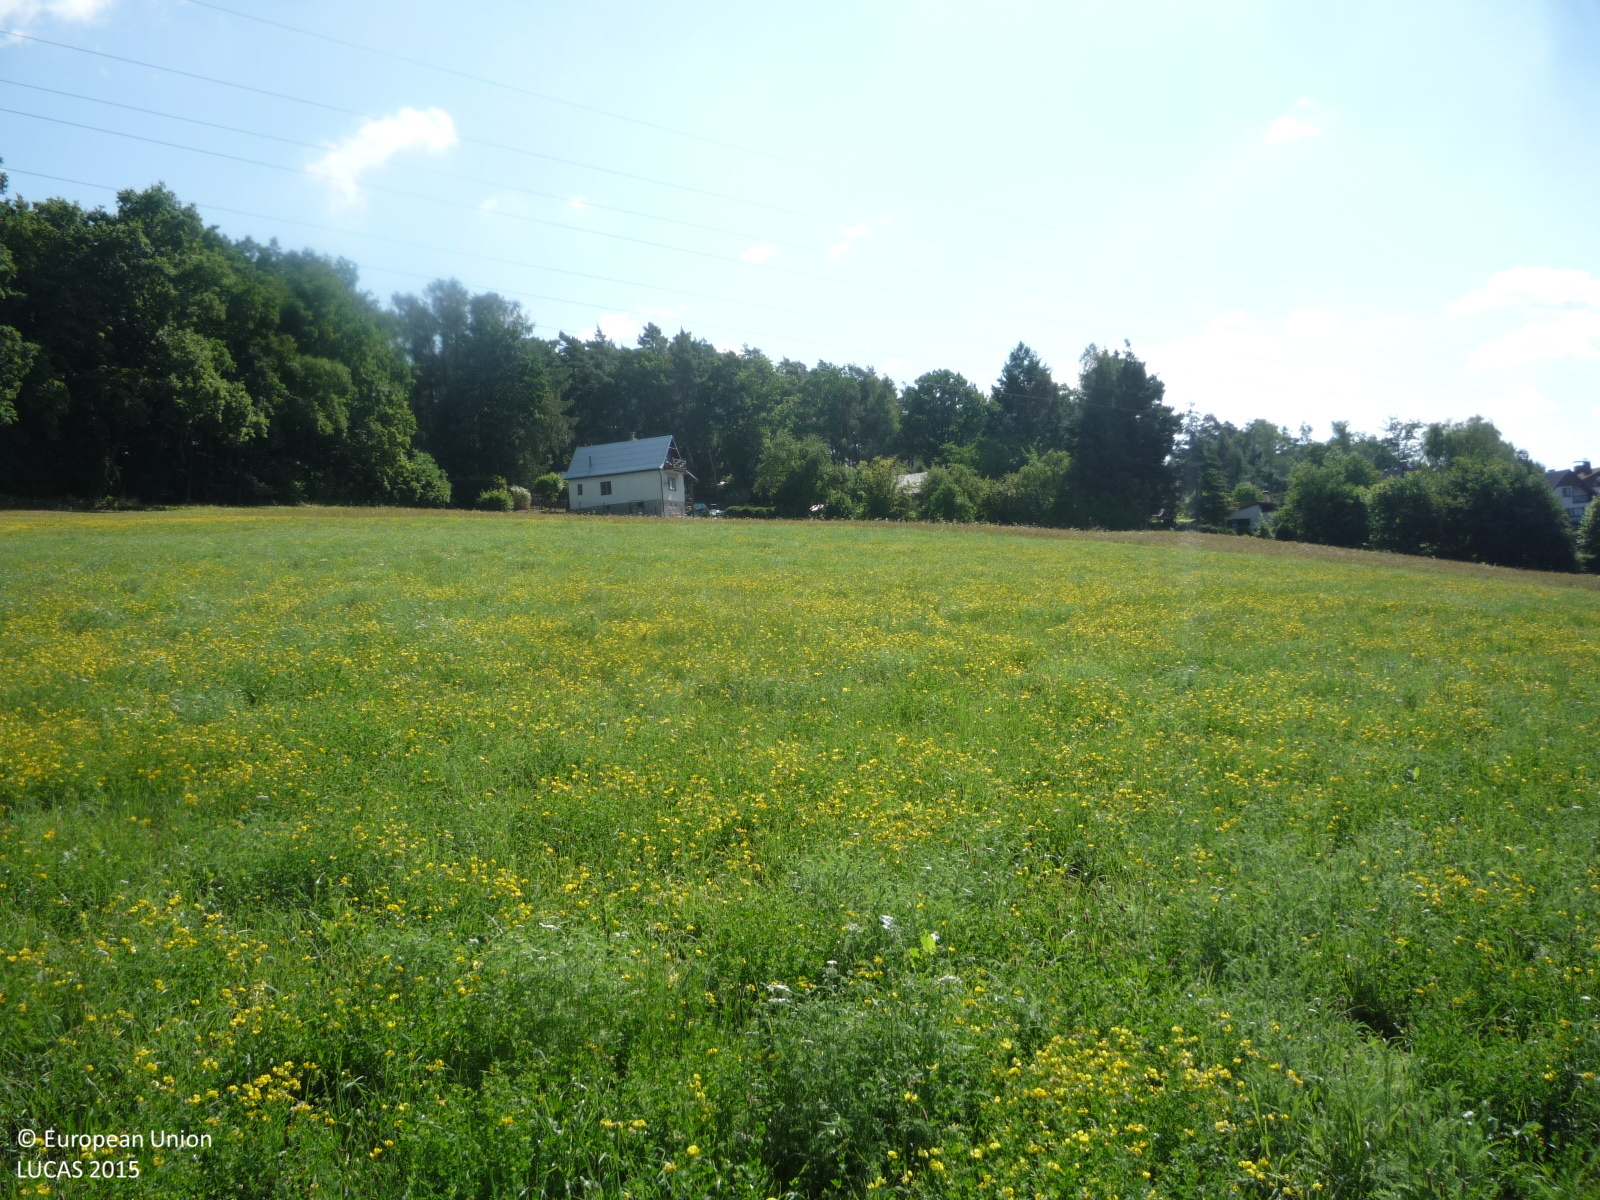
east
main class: Grassland
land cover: Grassland without tree/shrub cover
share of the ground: > 75 %
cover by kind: herbaceous plants 100 %
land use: Agriculture (excluding fallow land and kitchen gardens)
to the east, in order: Grassland without tree/shrub cover; Electric lines; Grassland without tree/shrub cover; Artificial constructions in urban areas; Pine dominated mixed woodland
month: July
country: CZ
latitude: 50.5324
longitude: 15.2375
